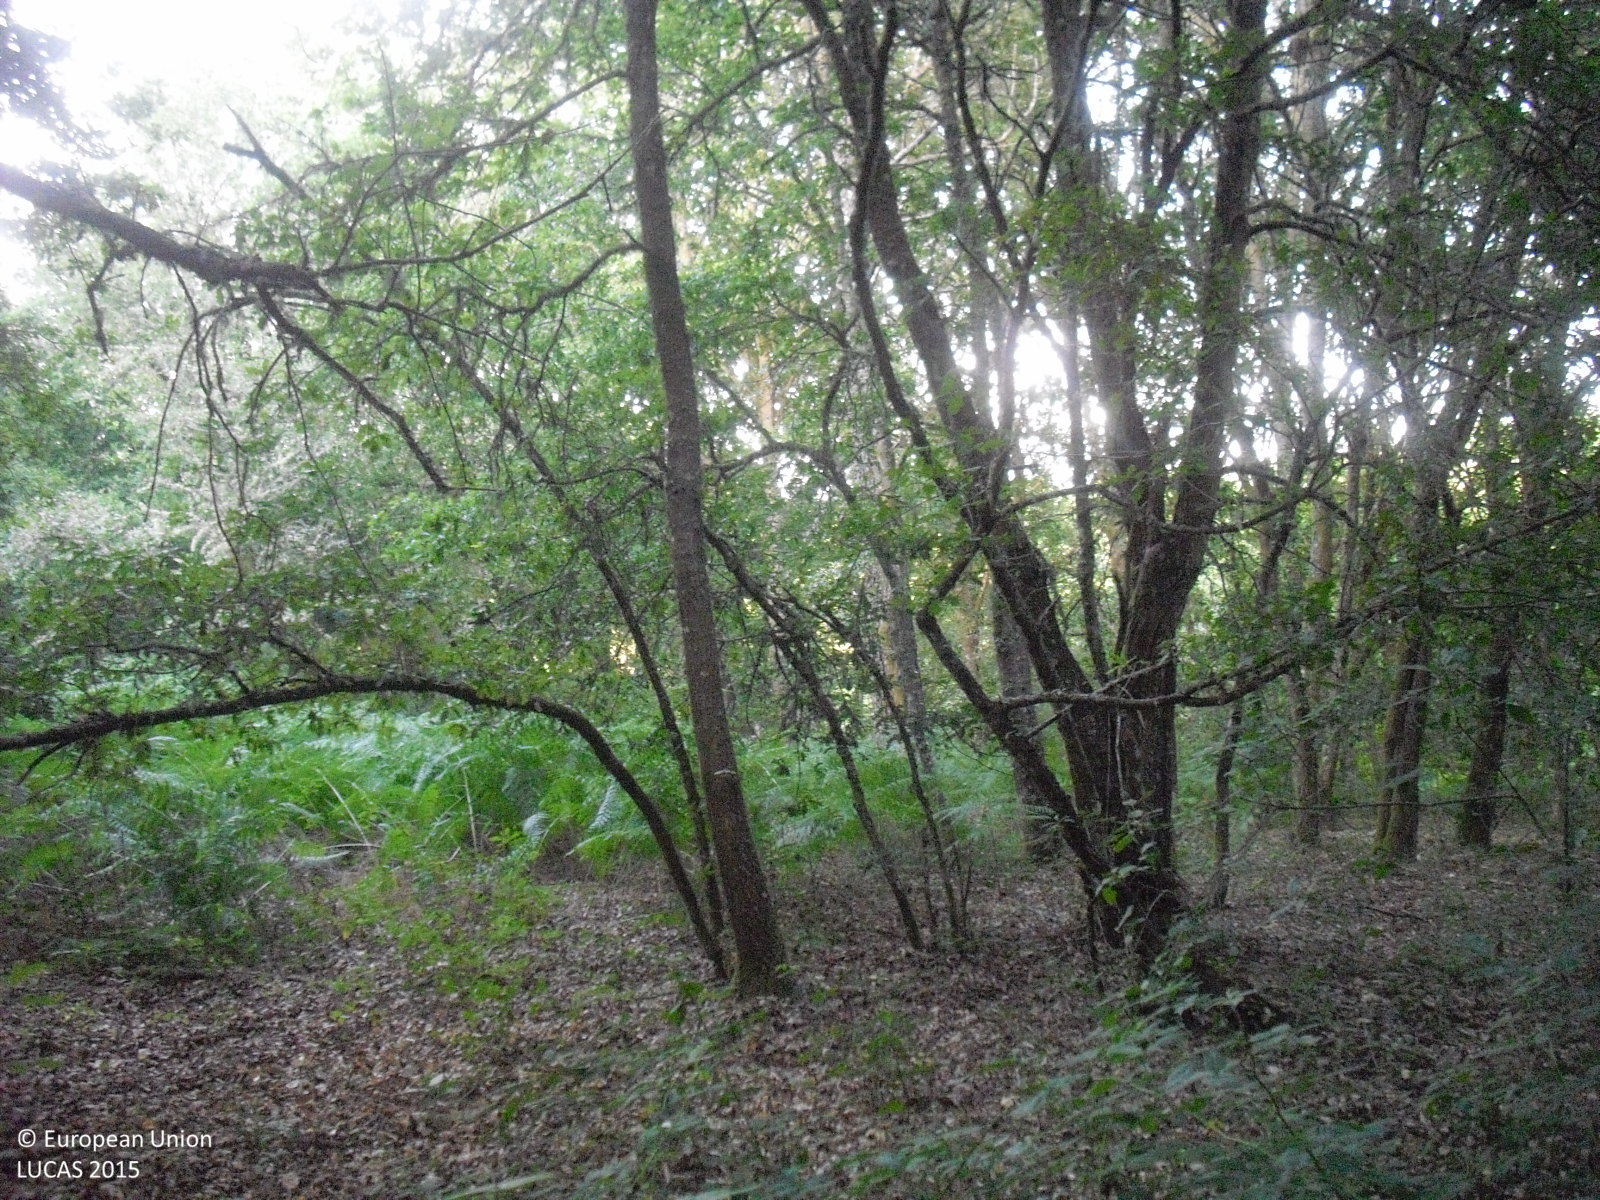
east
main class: Woodland
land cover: Broadleaved woodland
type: acidophilous oak and oak-birch forest
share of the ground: > 75 %
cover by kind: broadleaved forest trees 70 %, shrubs 30 %
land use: Forestry
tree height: > 5 m
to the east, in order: Broadleaved woodland; Dry stone walls; Broadleaved woodland; Fences; Shruby margins; Grassland without tree/shrub cover; Grassland with sparse tree/shrub cover; Rivers and streams; Broadleaved woodland
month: July
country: ES
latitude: 42.3292
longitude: -7.7304
